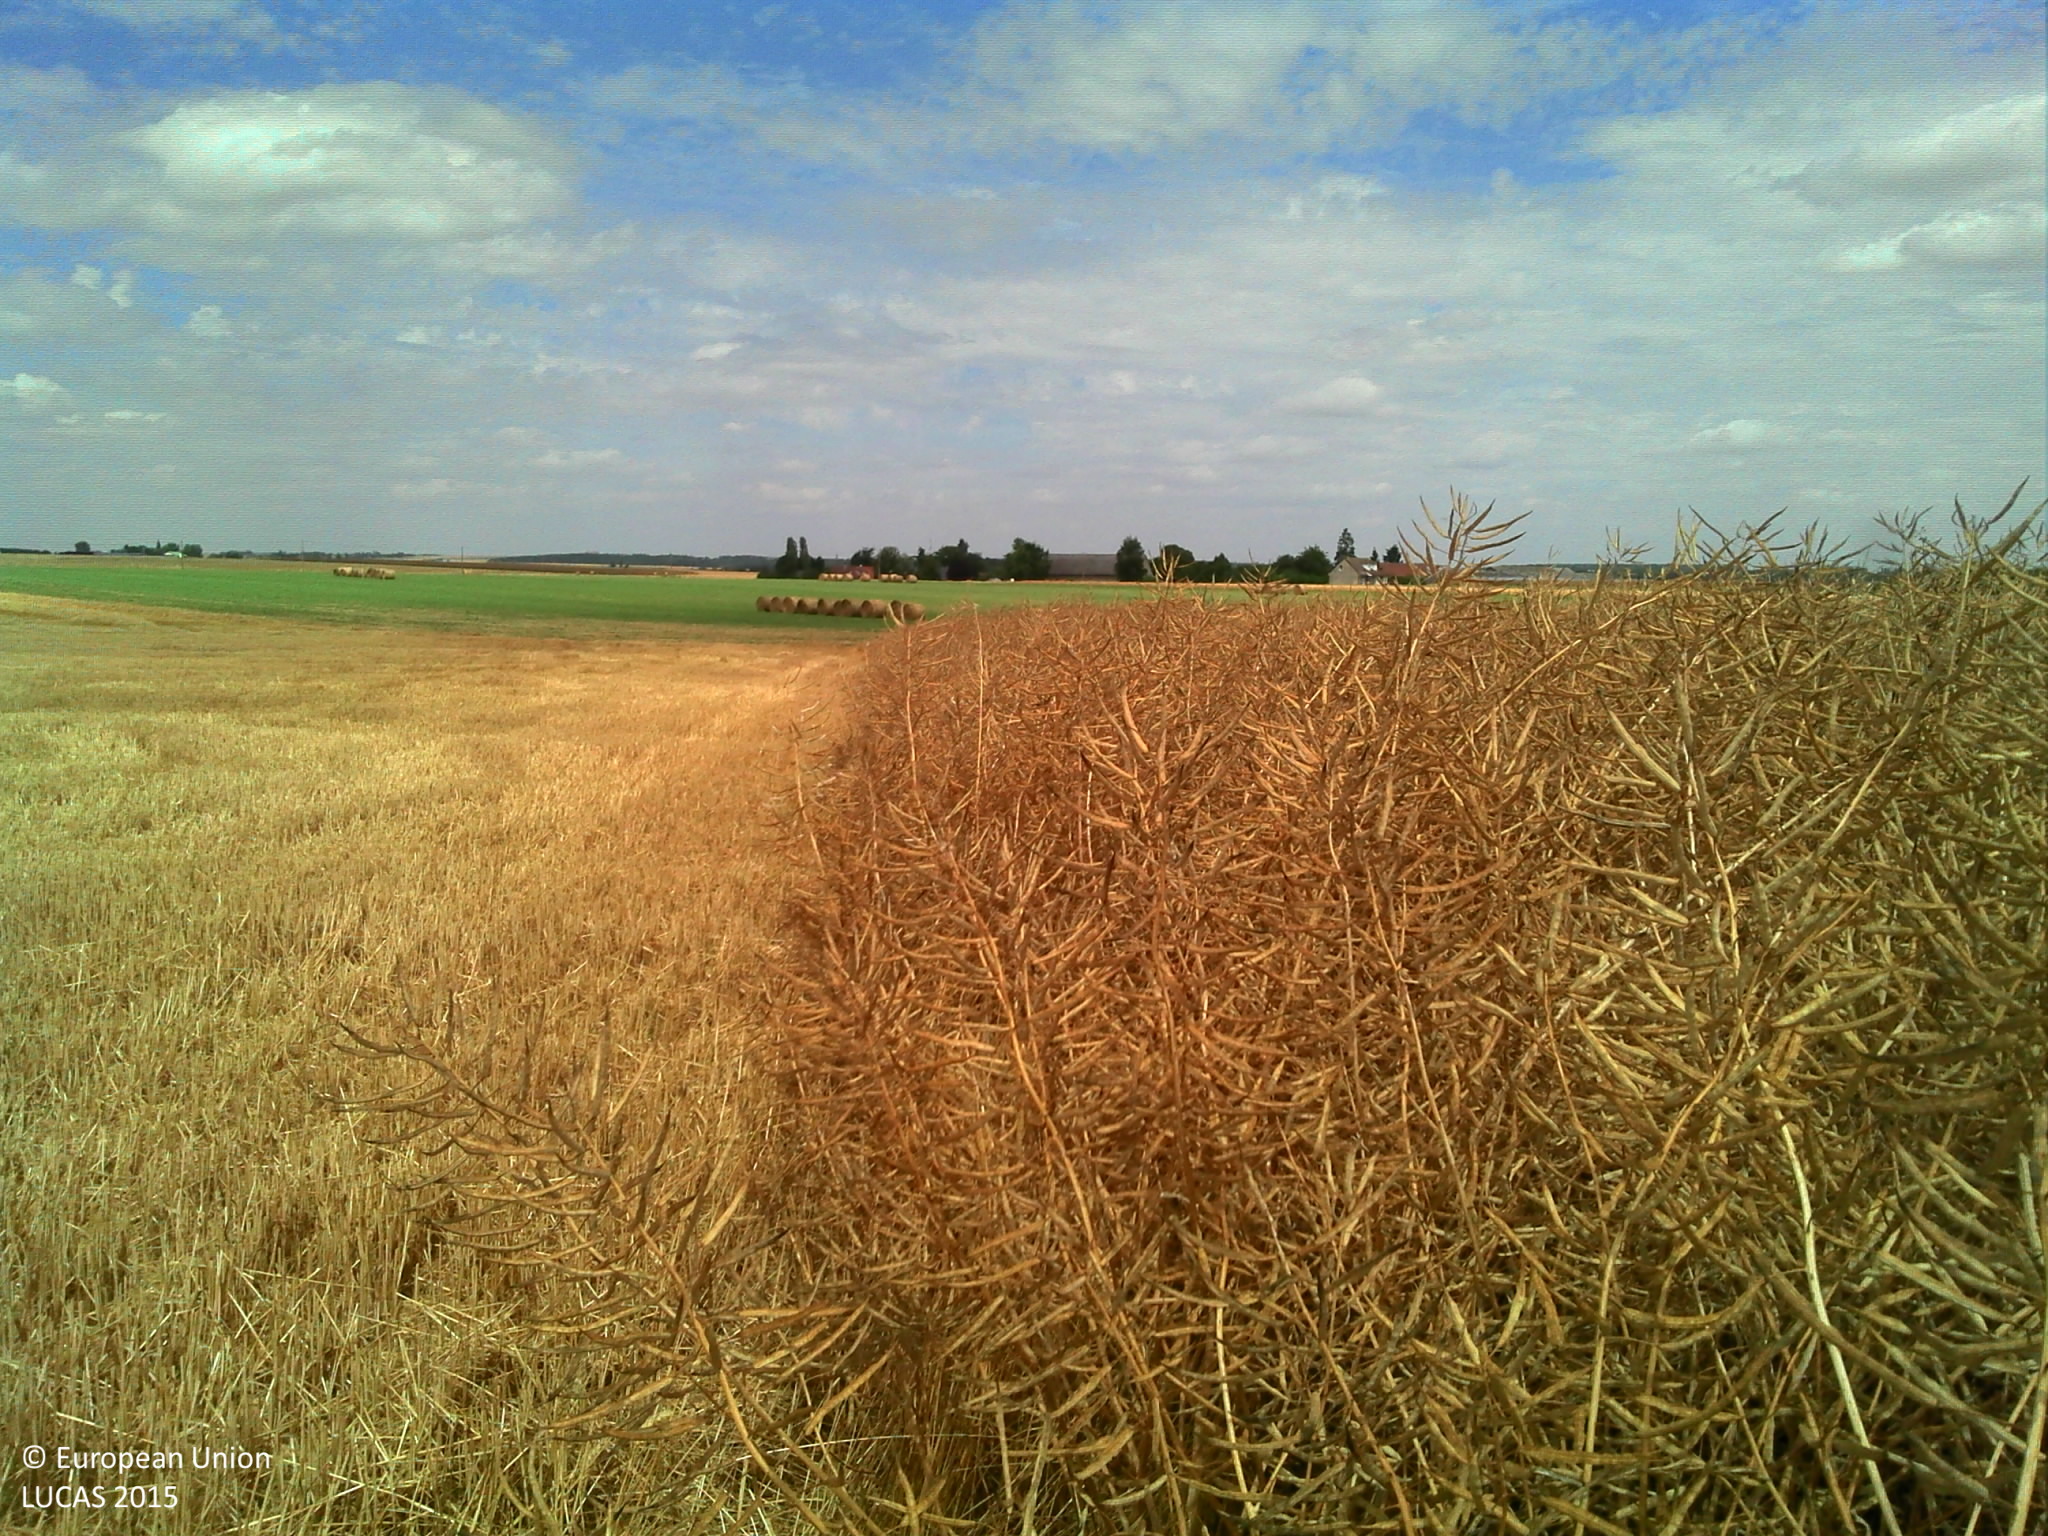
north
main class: Cropland
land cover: Rape and turnip rape
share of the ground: > 75 %
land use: Agriculture (excluding fallow land and kitchen gardens)
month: July
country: FR
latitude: 48.4707
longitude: 1.2300
